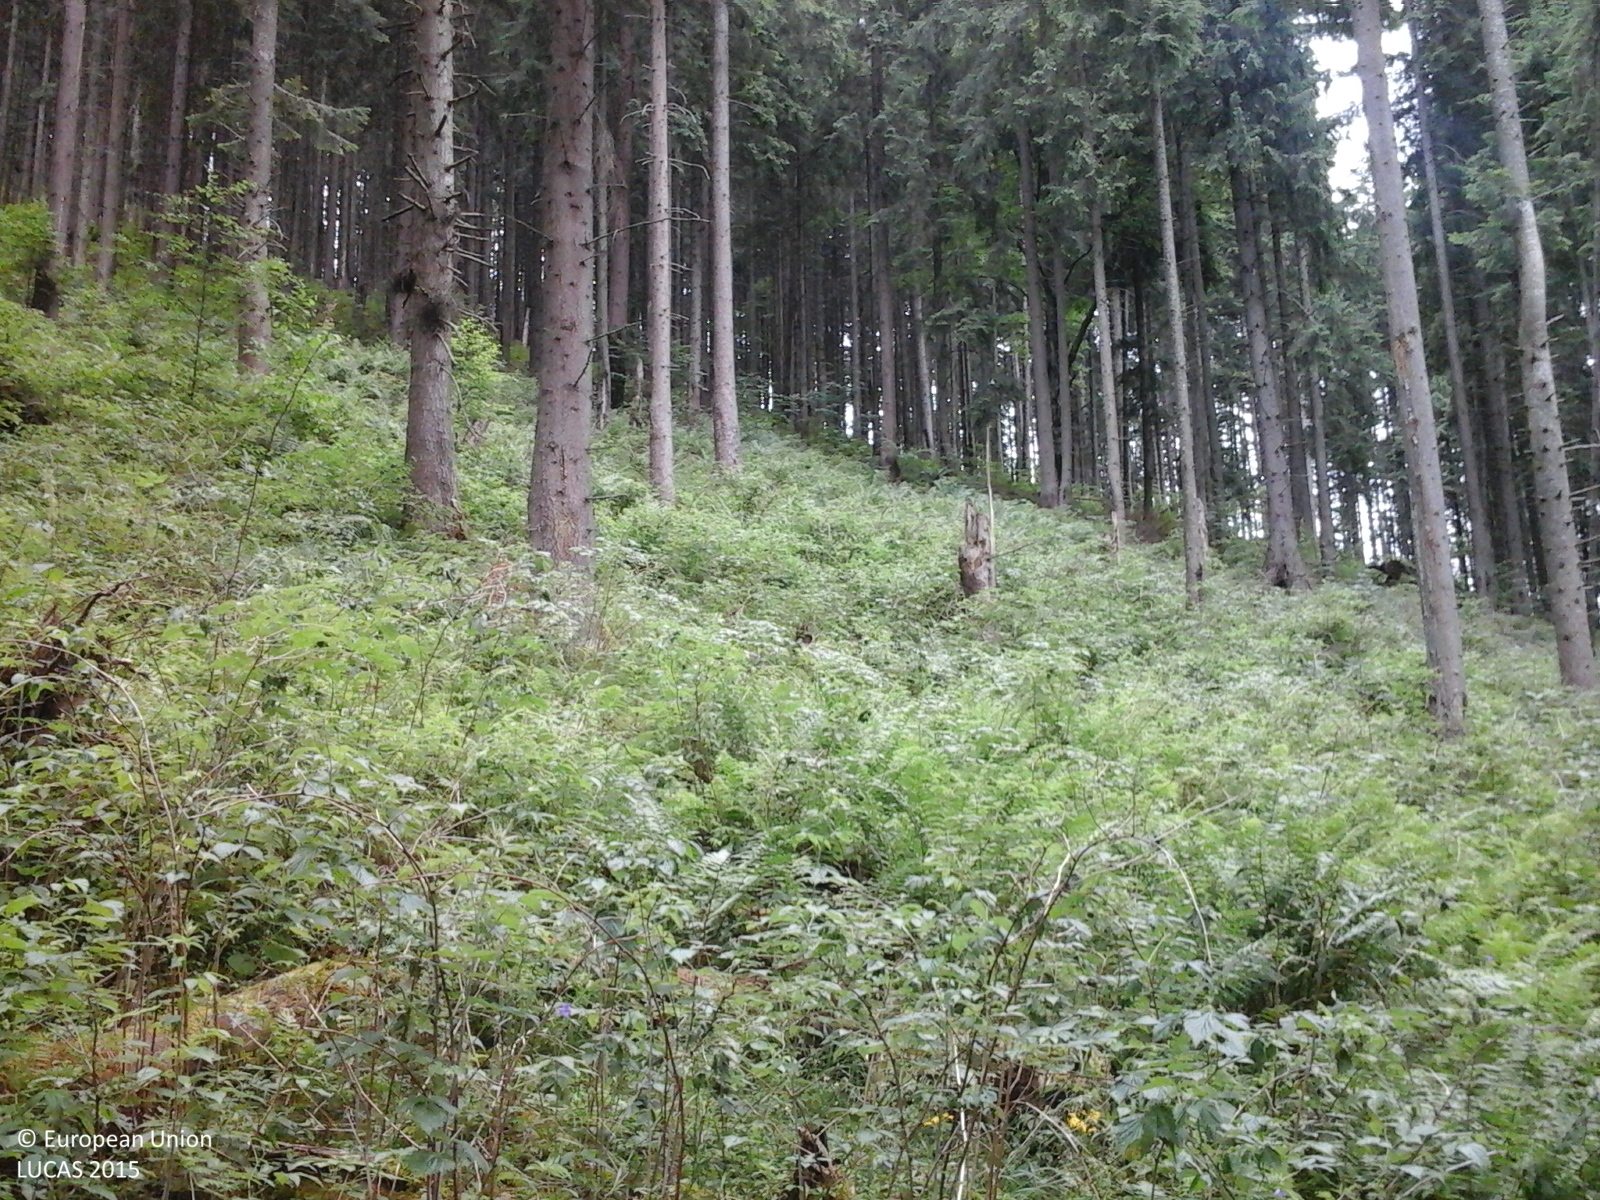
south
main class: Woodland
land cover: Spruce dominated coniferous woodland
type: alpine coniferous forest
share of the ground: > 75 %
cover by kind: coniferous forest trees 90 %, herbaceous plants 10 %
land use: Forestry
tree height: > 5 m
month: June
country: RO
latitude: 47.5667
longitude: 25.4408
